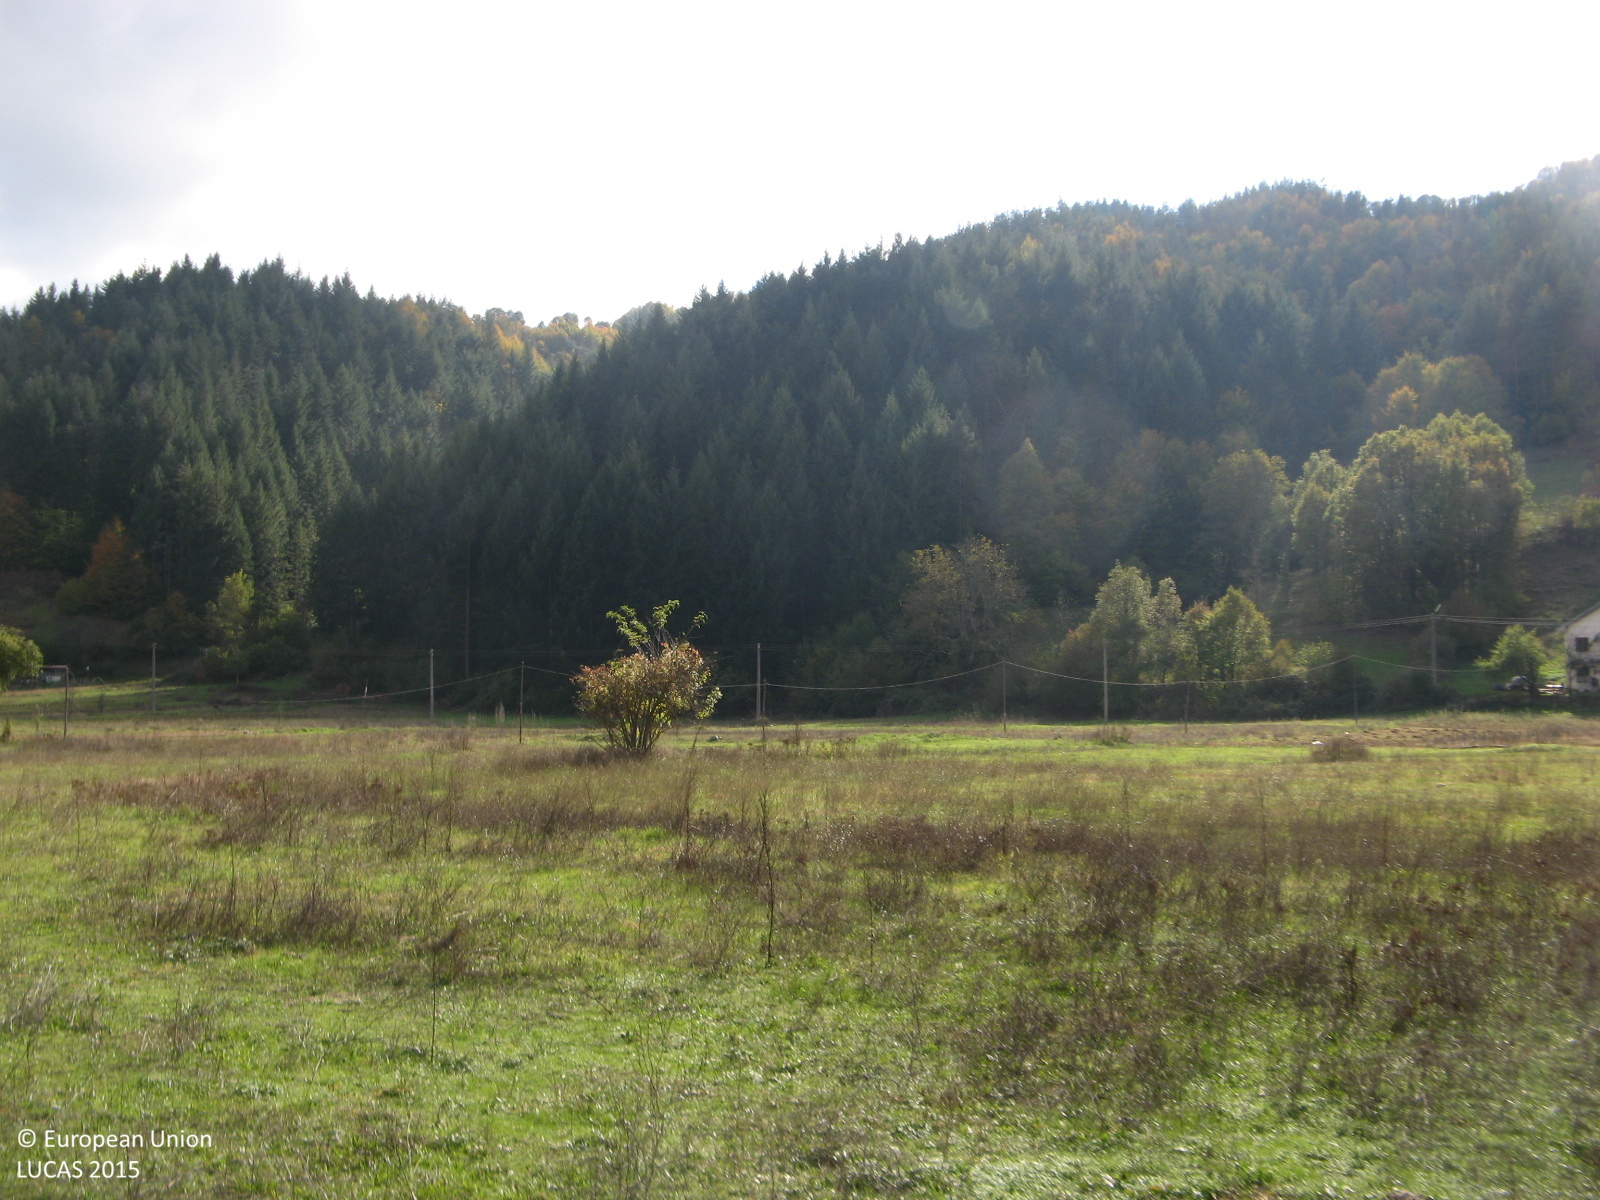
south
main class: Grassland
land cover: Grassland without tree/shrub cover
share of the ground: > 75 %
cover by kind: herbaceous plants 100 %
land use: Agriculture (excluding fallow land and kitchen gardens)
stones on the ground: < 10 %
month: October
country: BG
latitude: 41.4384
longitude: 25.1173
